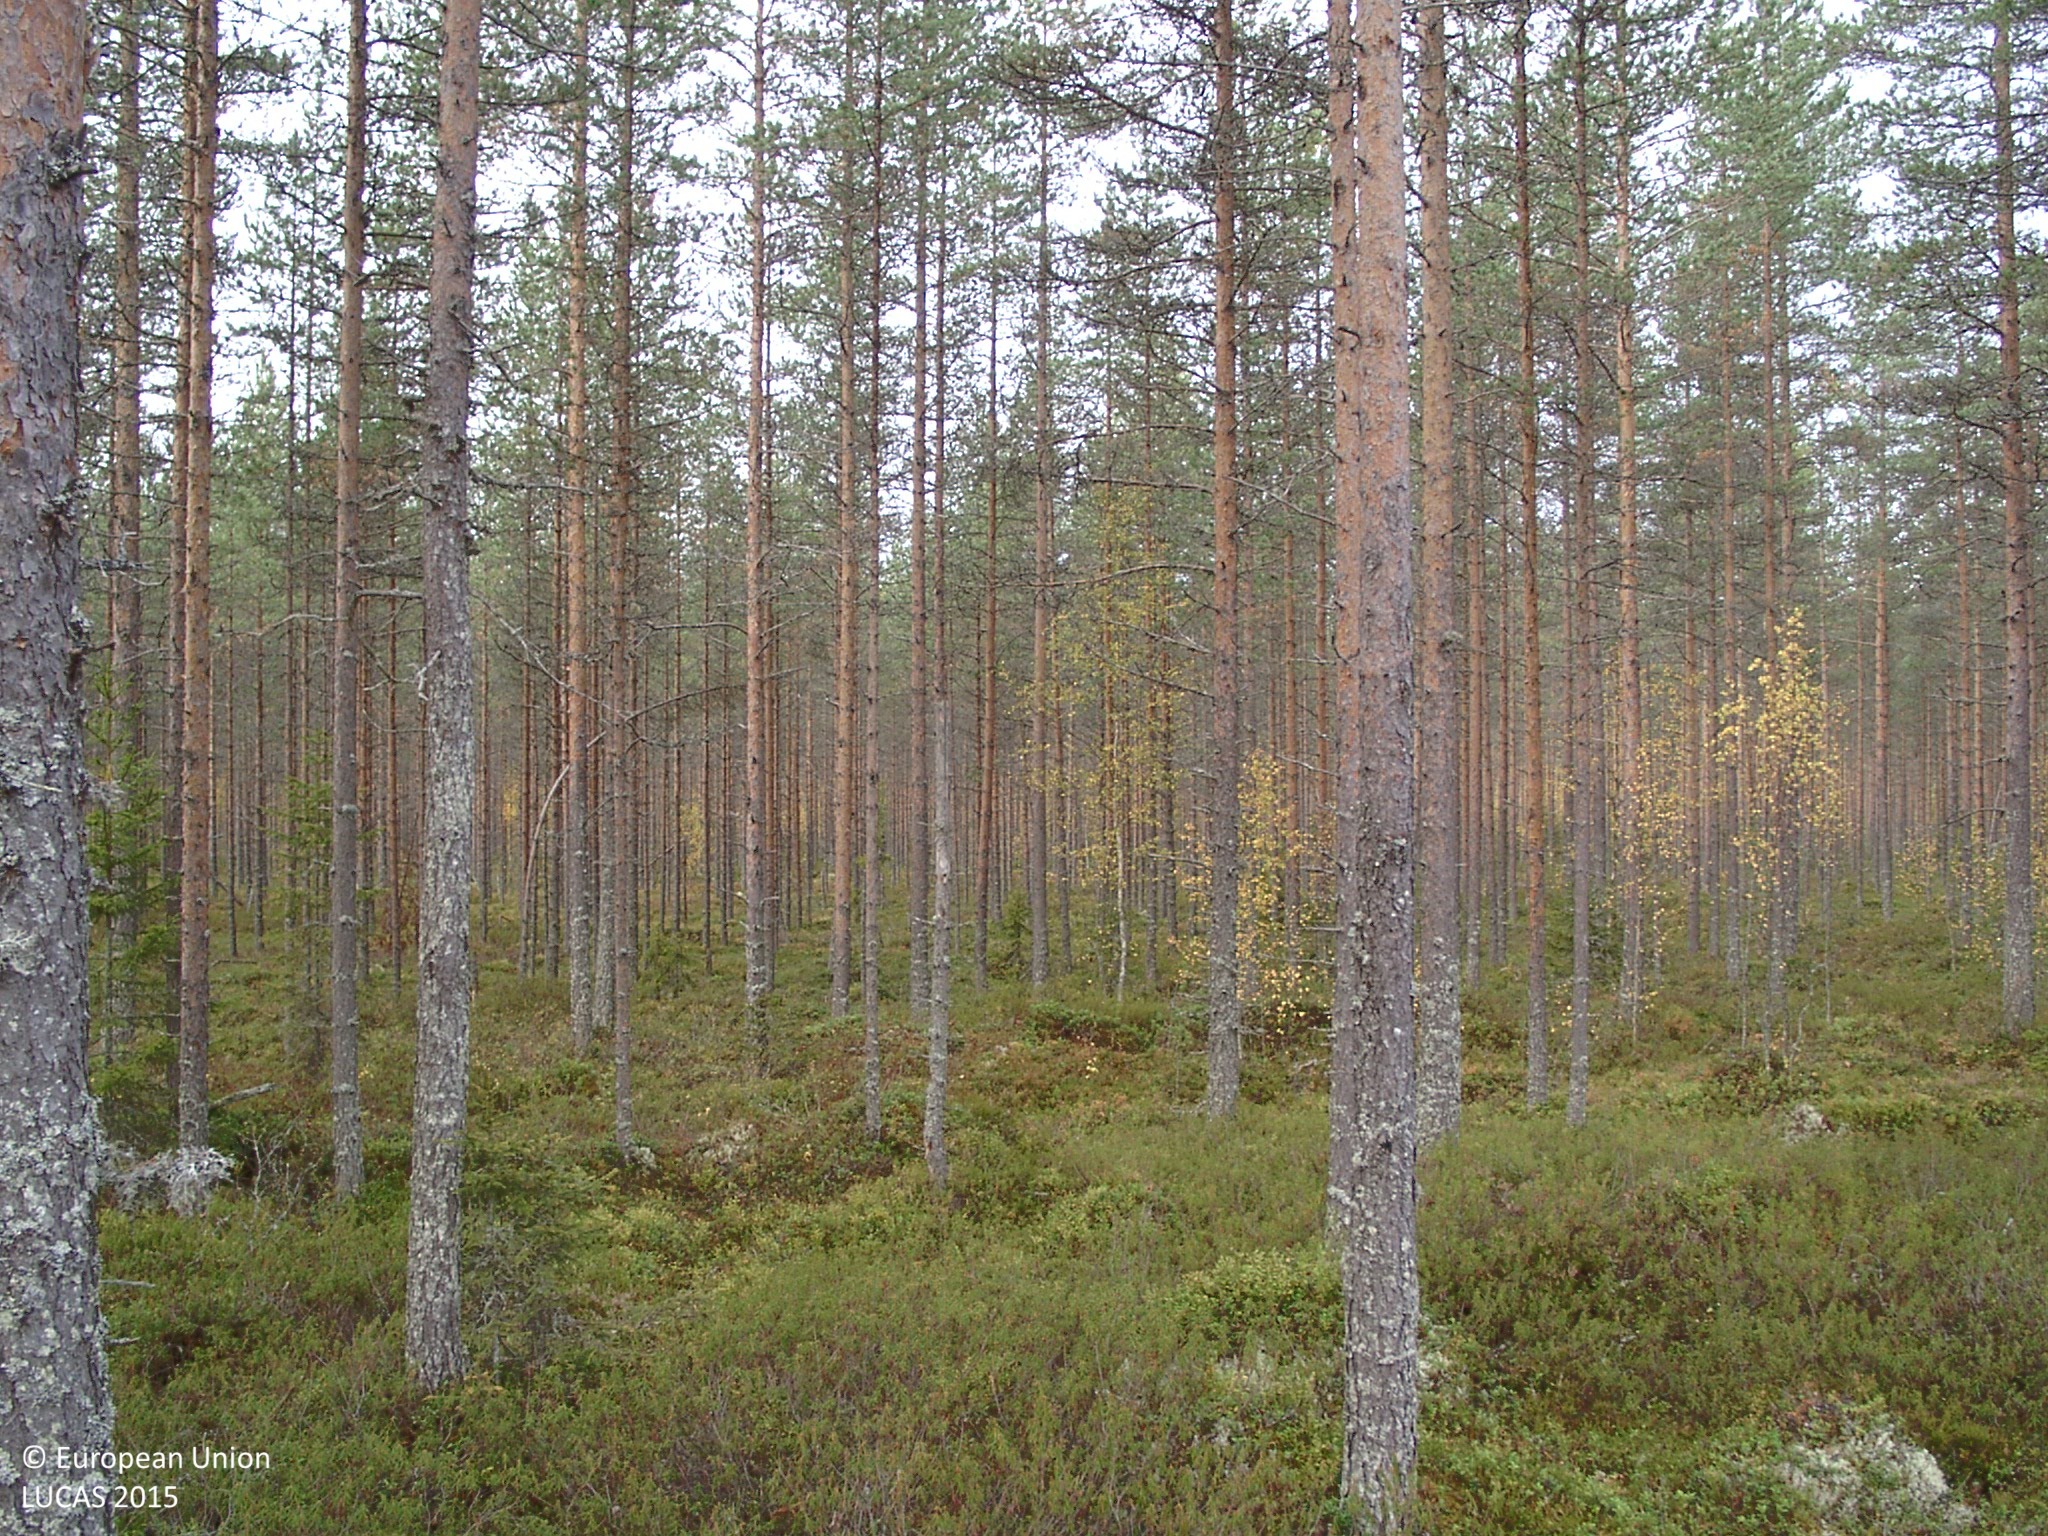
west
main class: Woodland
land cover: Pine dominated coniferous woodland
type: boreal forest
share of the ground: 25 - 50 %
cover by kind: shrubs 45 %, coniferous forest trees 30 %, lichens and mosses 25 %
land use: Forestry
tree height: > 5 m
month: September
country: FI
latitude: 62.5896
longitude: 24.8353
